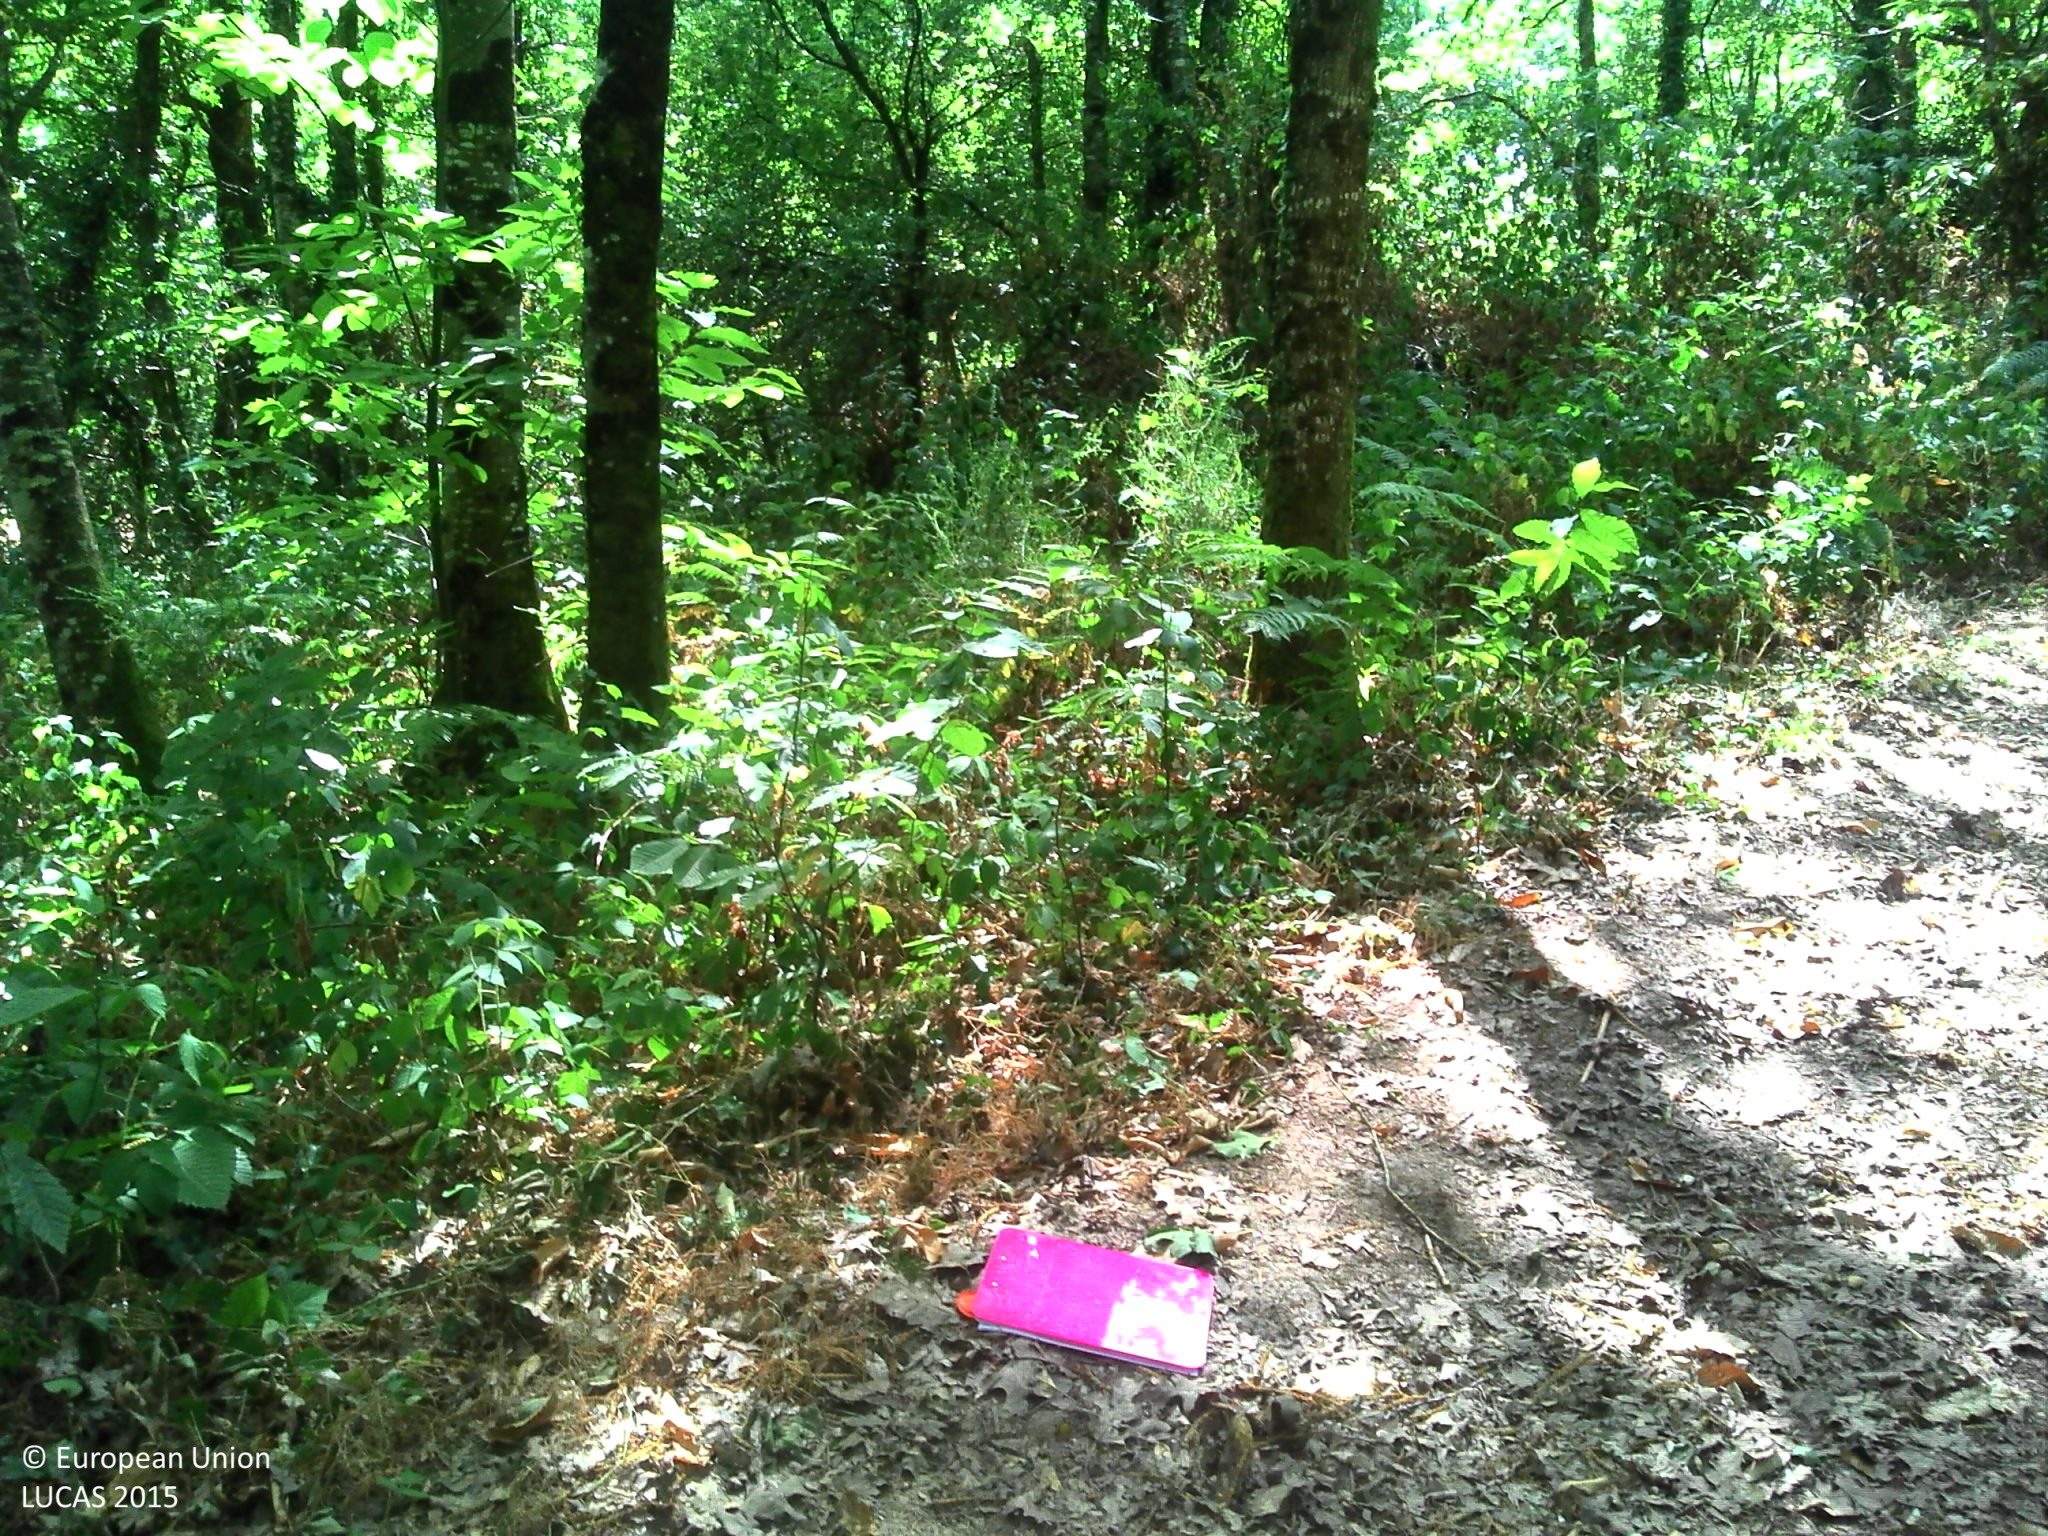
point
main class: Woodland
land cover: Broadleaved woodland
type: exotic forest
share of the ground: > 75 %
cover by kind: broadleaved forest trees 100 %
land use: Forestry
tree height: > 5 m
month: July
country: FR
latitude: 45.9706
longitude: 0.9933
